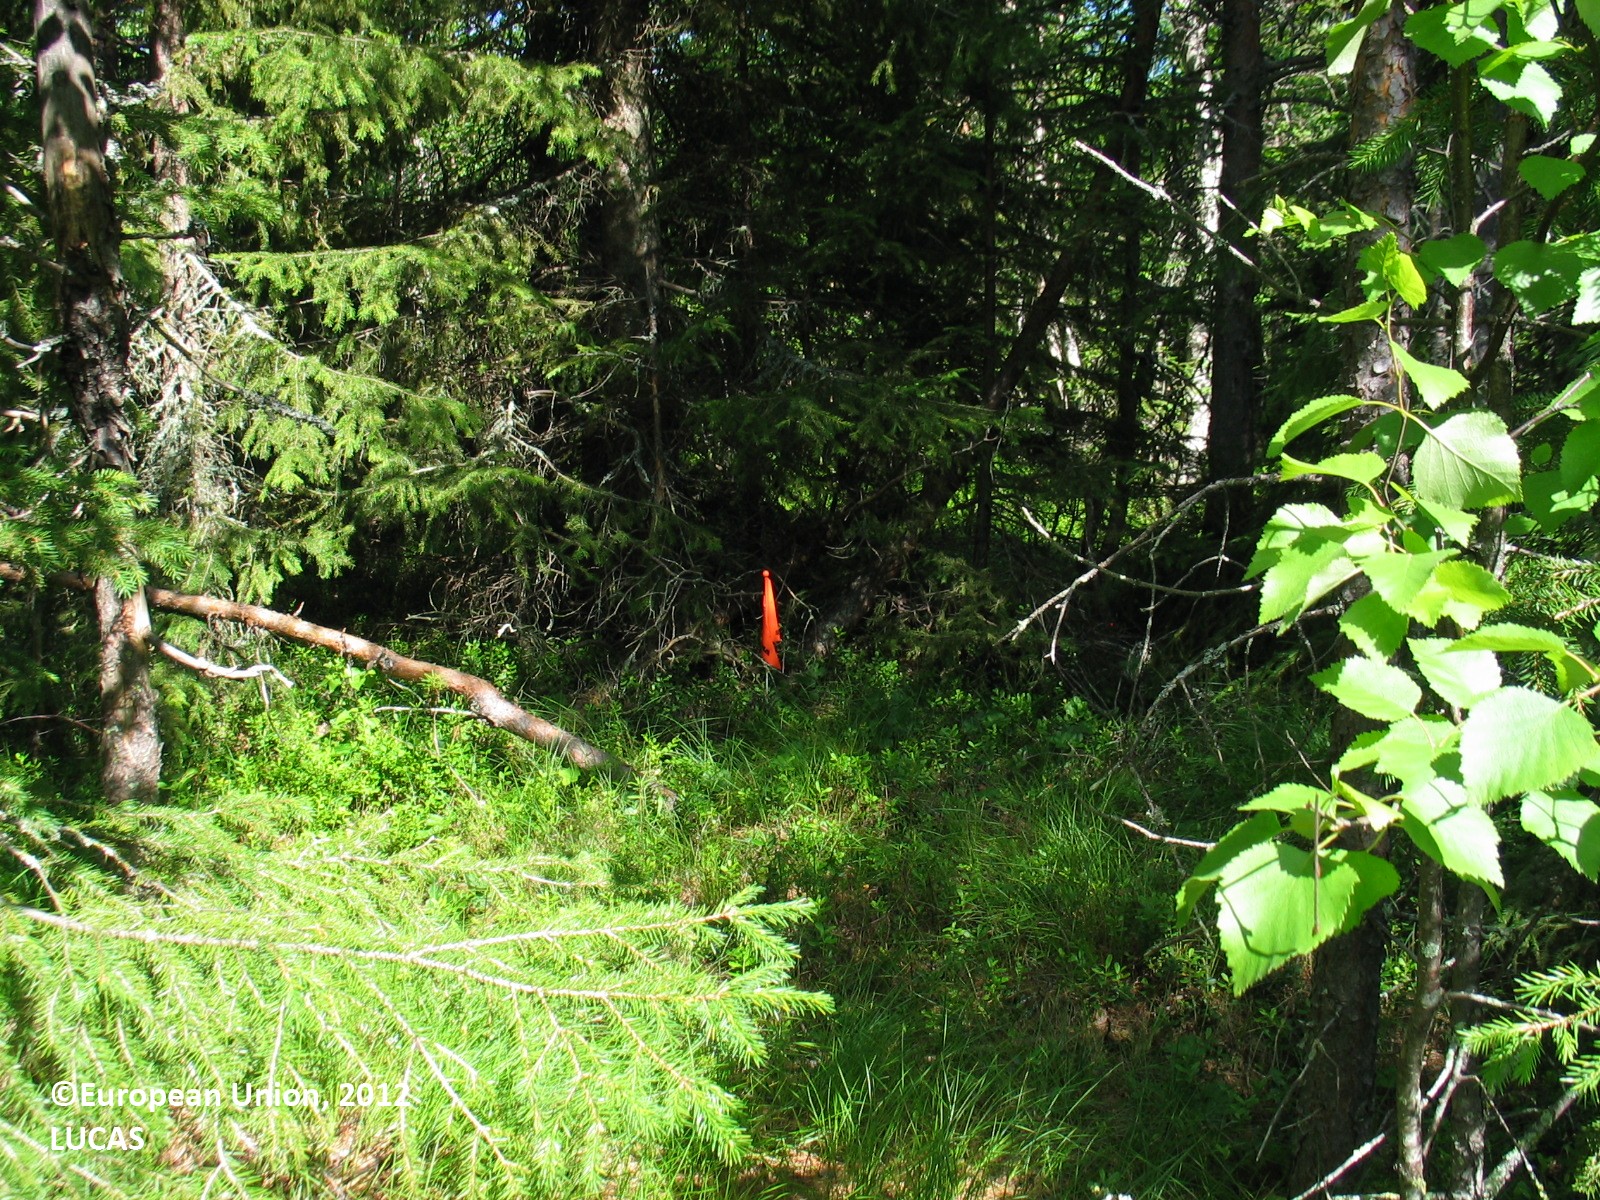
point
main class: Woodland
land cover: Pine dominated coniferous woodland
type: mire and swamp forests
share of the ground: 50 - 75 %
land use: Forestry
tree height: > 5 m
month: July
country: FI
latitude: 65.8180
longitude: 25.0500
